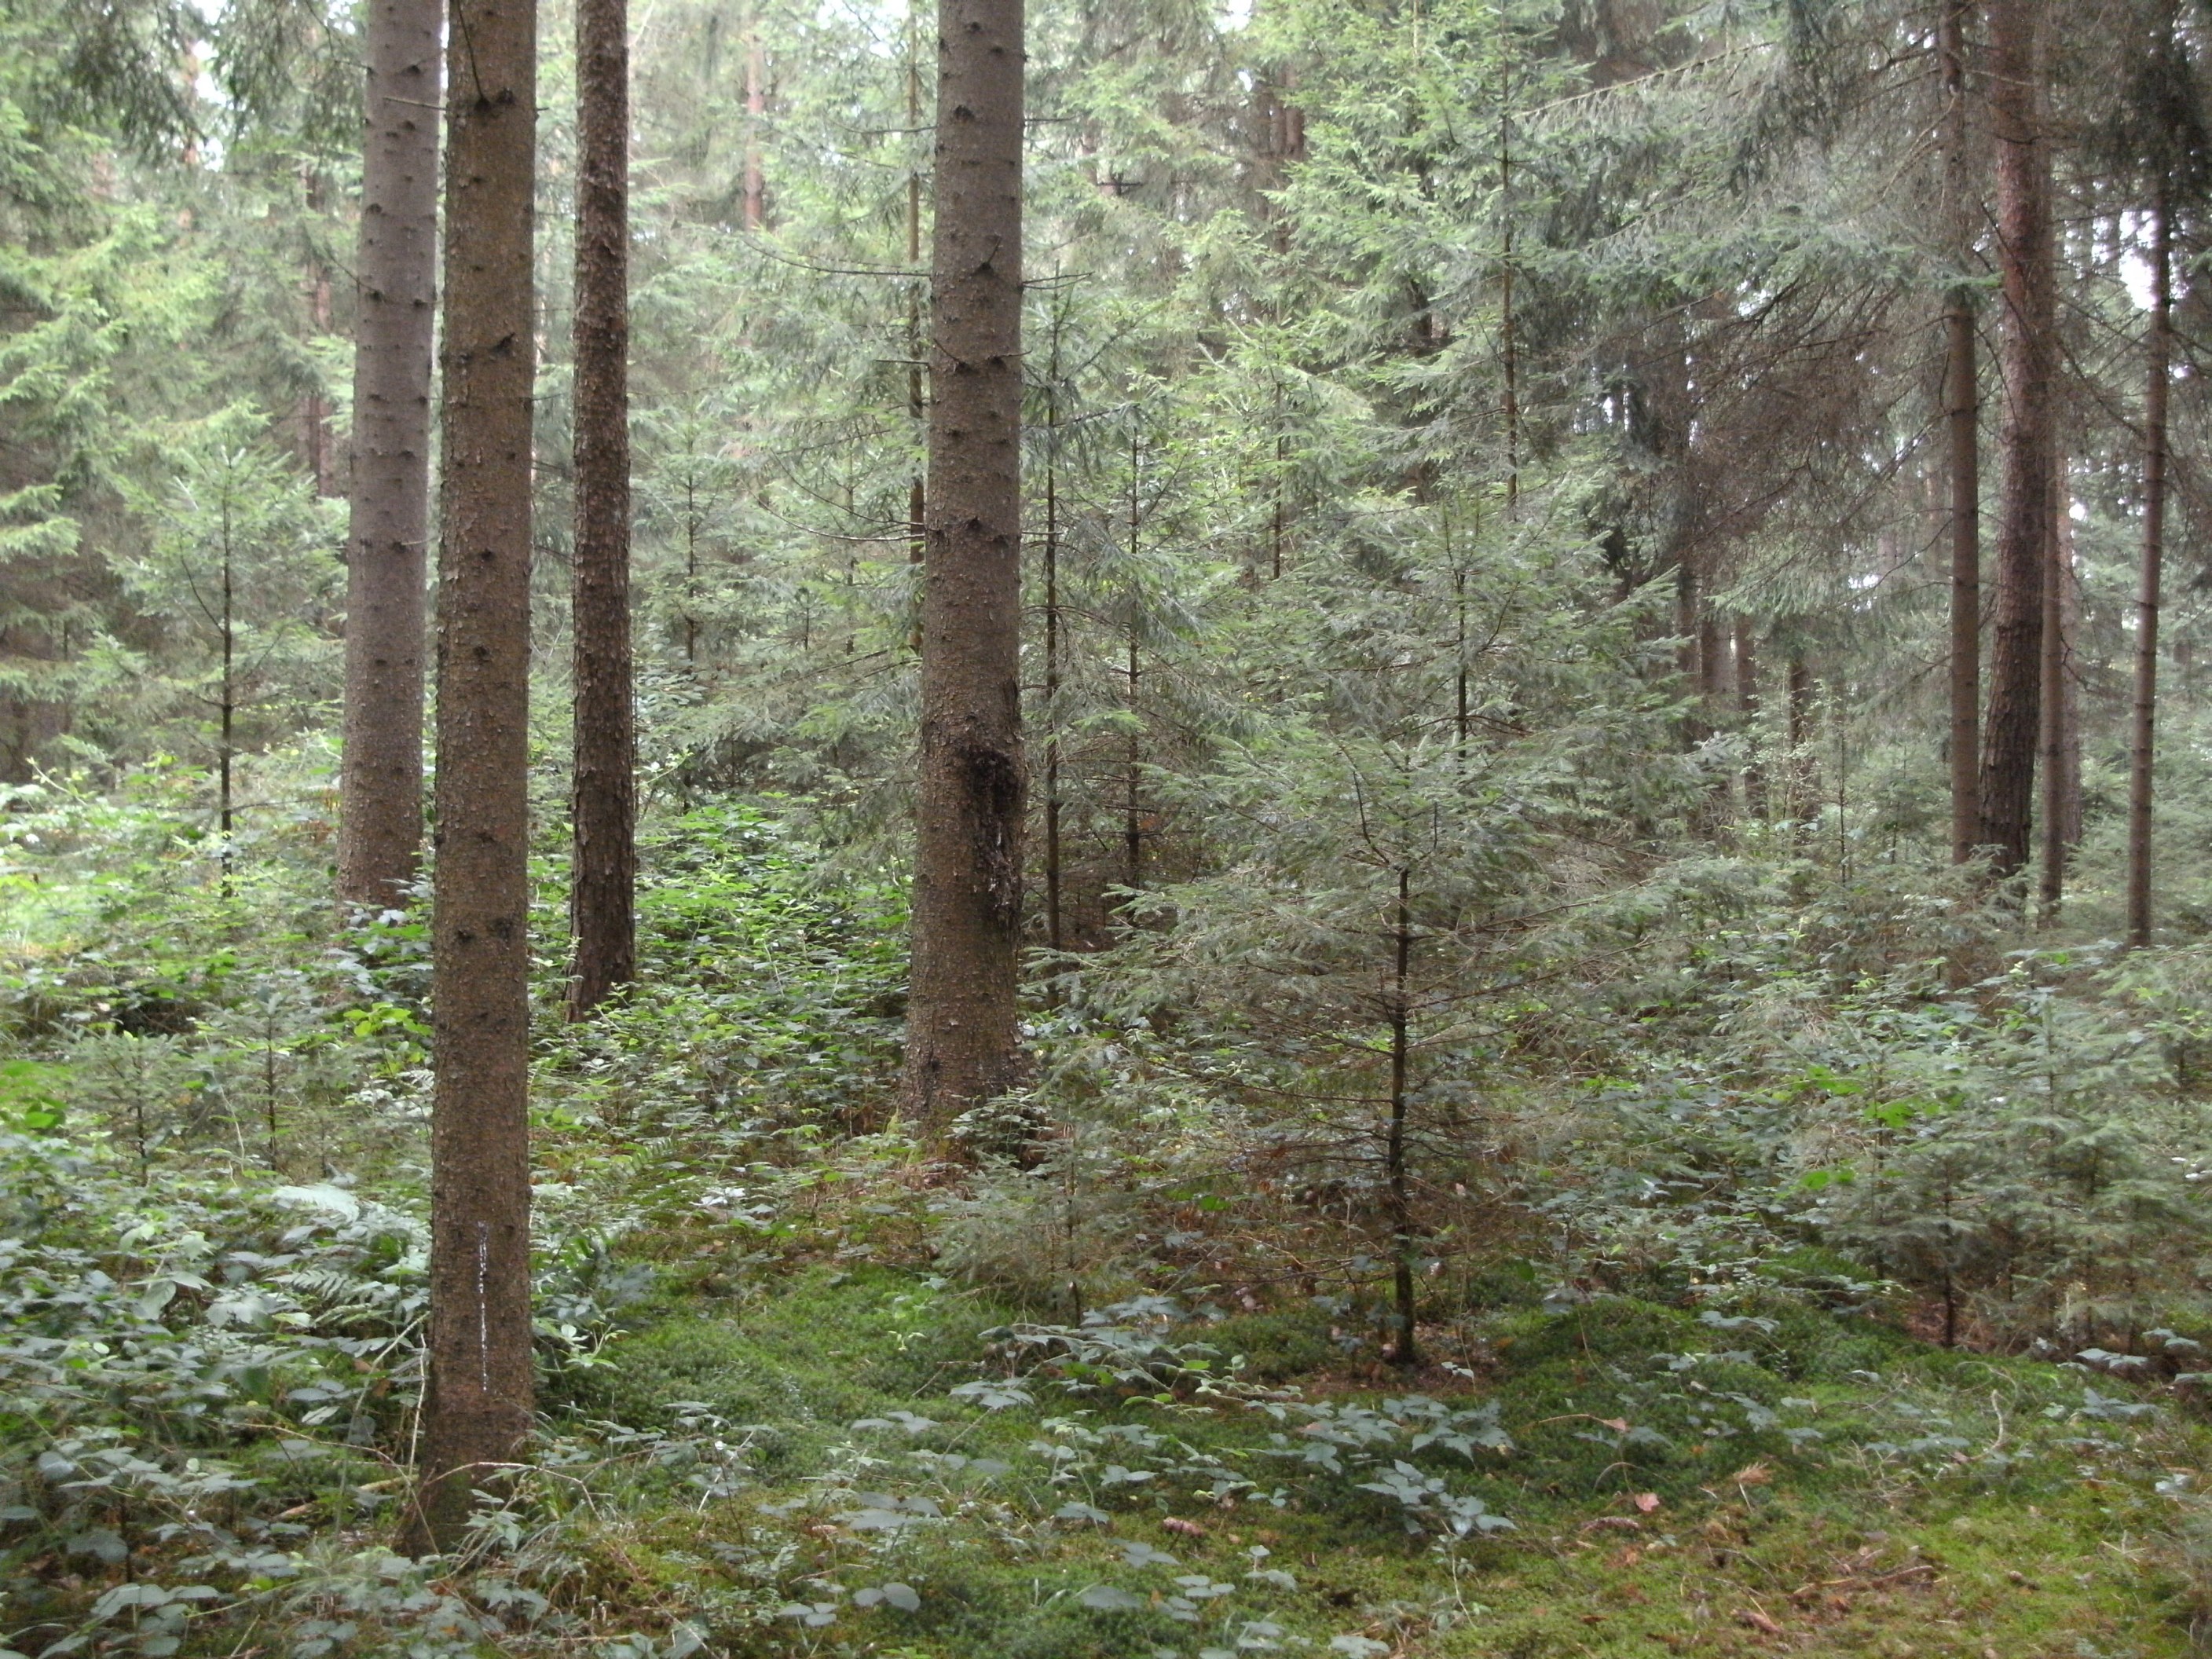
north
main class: Woodland
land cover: Other coniferous woodland
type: hemiboreal forest and nemoral coniferous forest and mixed broadleaved-coniferous forest
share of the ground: > 75 %
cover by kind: coniferous forest trees 85 %, shrubs 5 %, herbaceous plants 5 %, unconsolidated bare surface 5 %
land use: Forestry
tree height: > 5 m
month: July
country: AT
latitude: 46.6082
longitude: 14.7111
